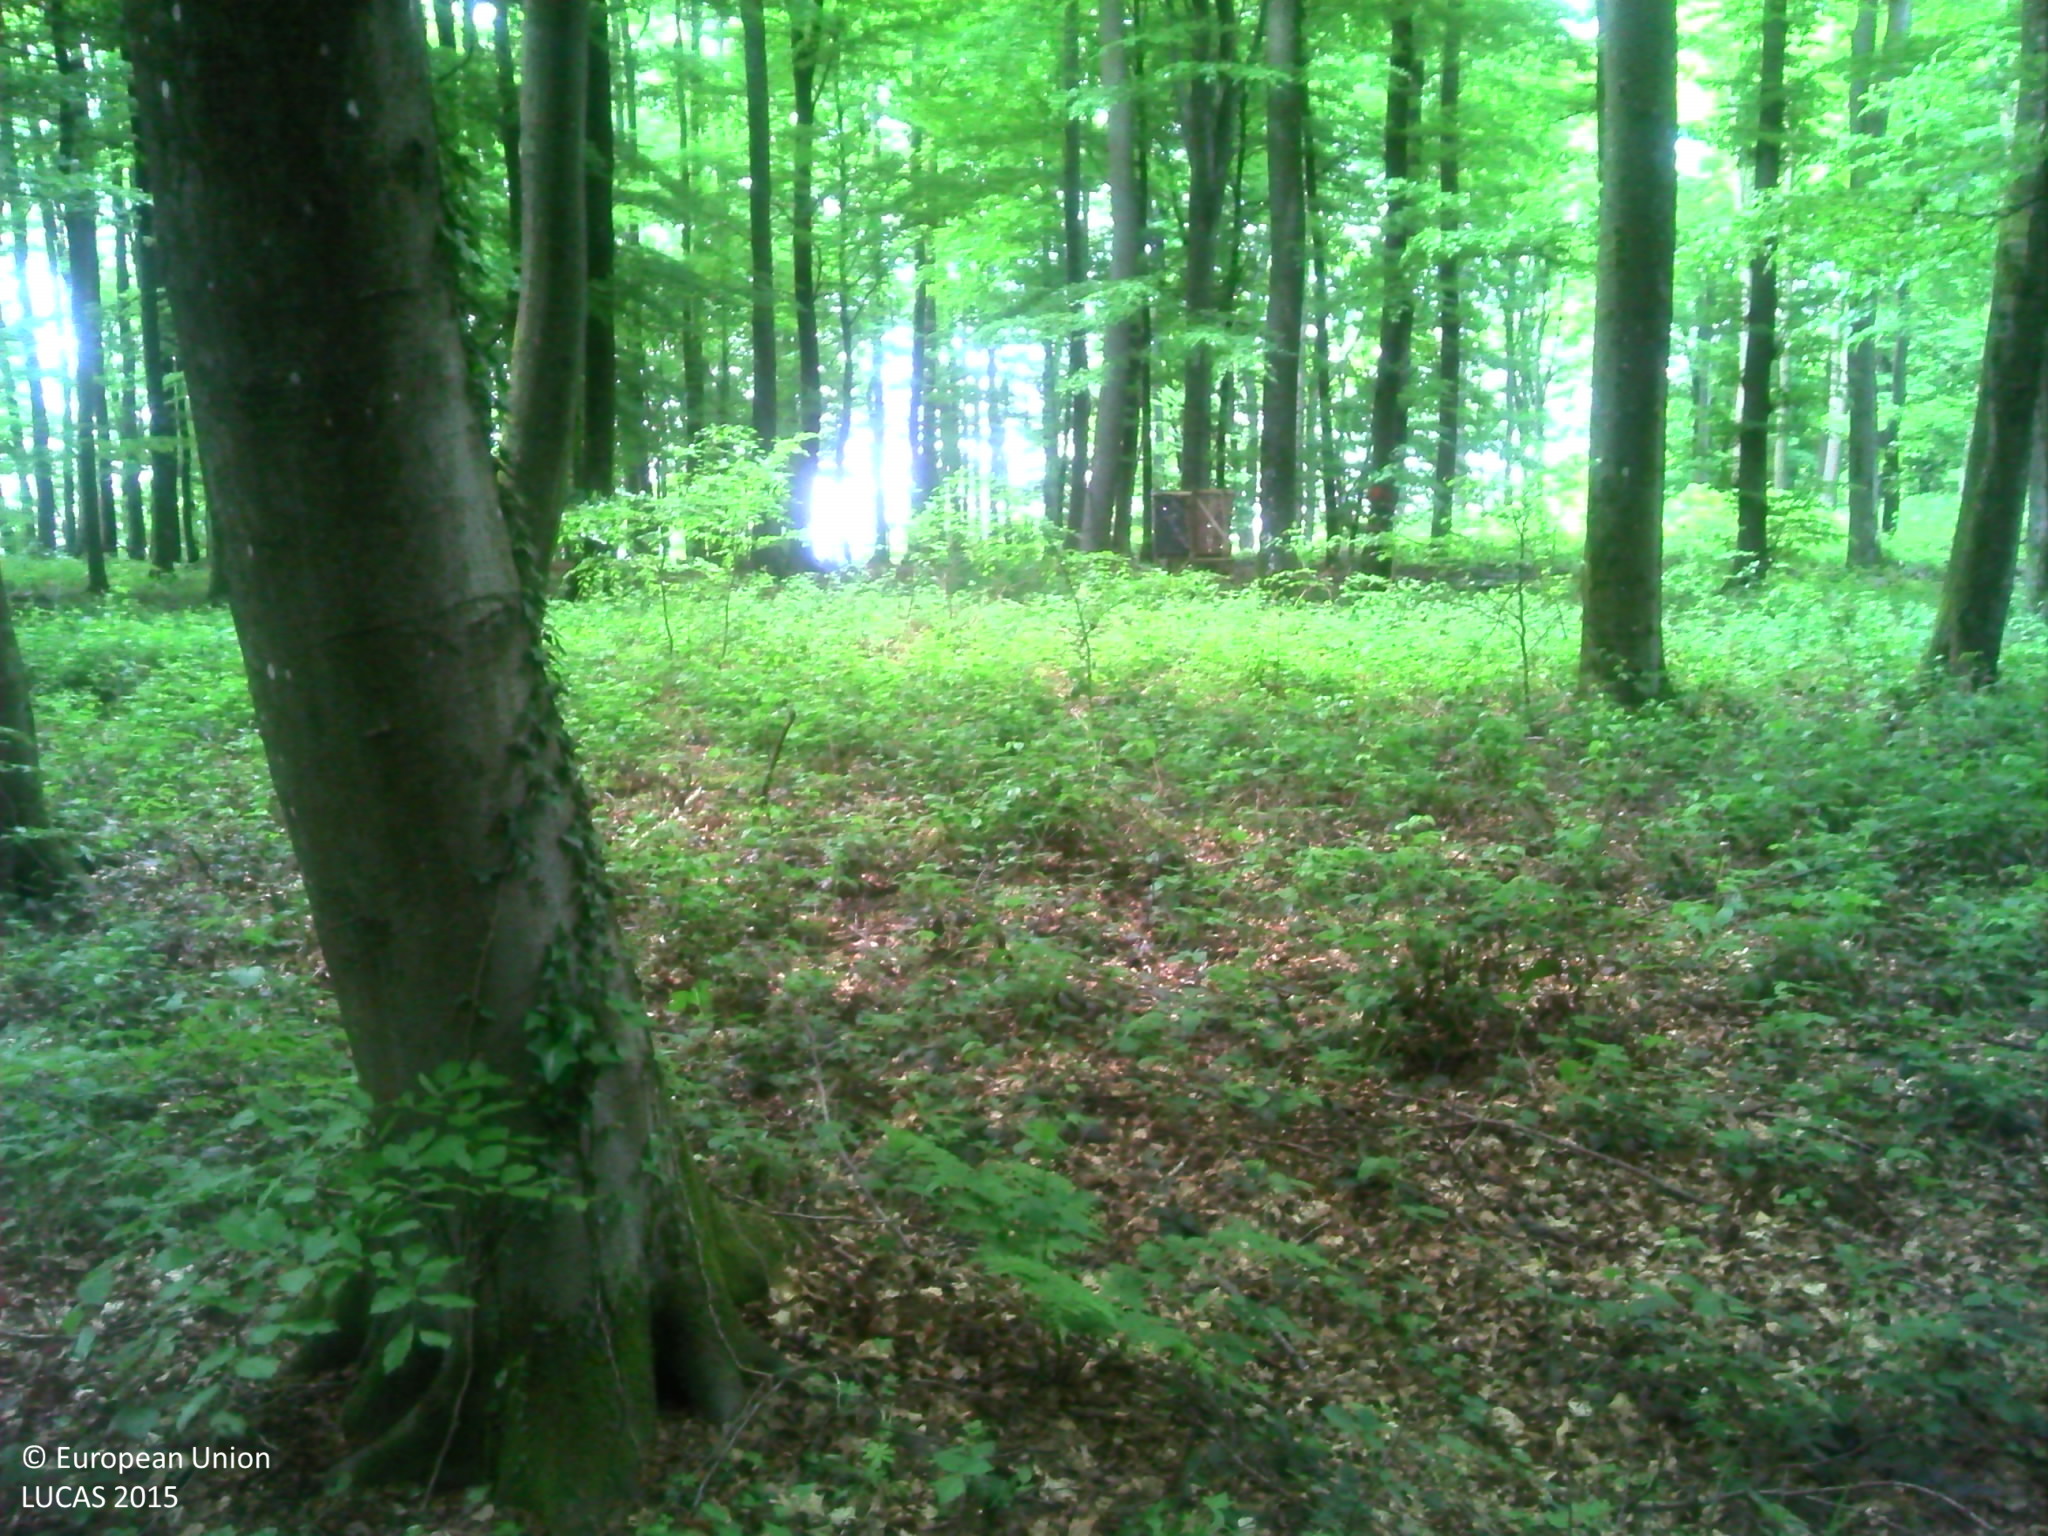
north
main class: Woodland
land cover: Broadleaved woodland
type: beech forest
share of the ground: > 75 %
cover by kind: broadleaved forest trees 90 %, herbaceous plants 10 %
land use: Forestry
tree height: > 5 m
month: May
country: LU
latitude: 49.7167
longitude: 5.9631
